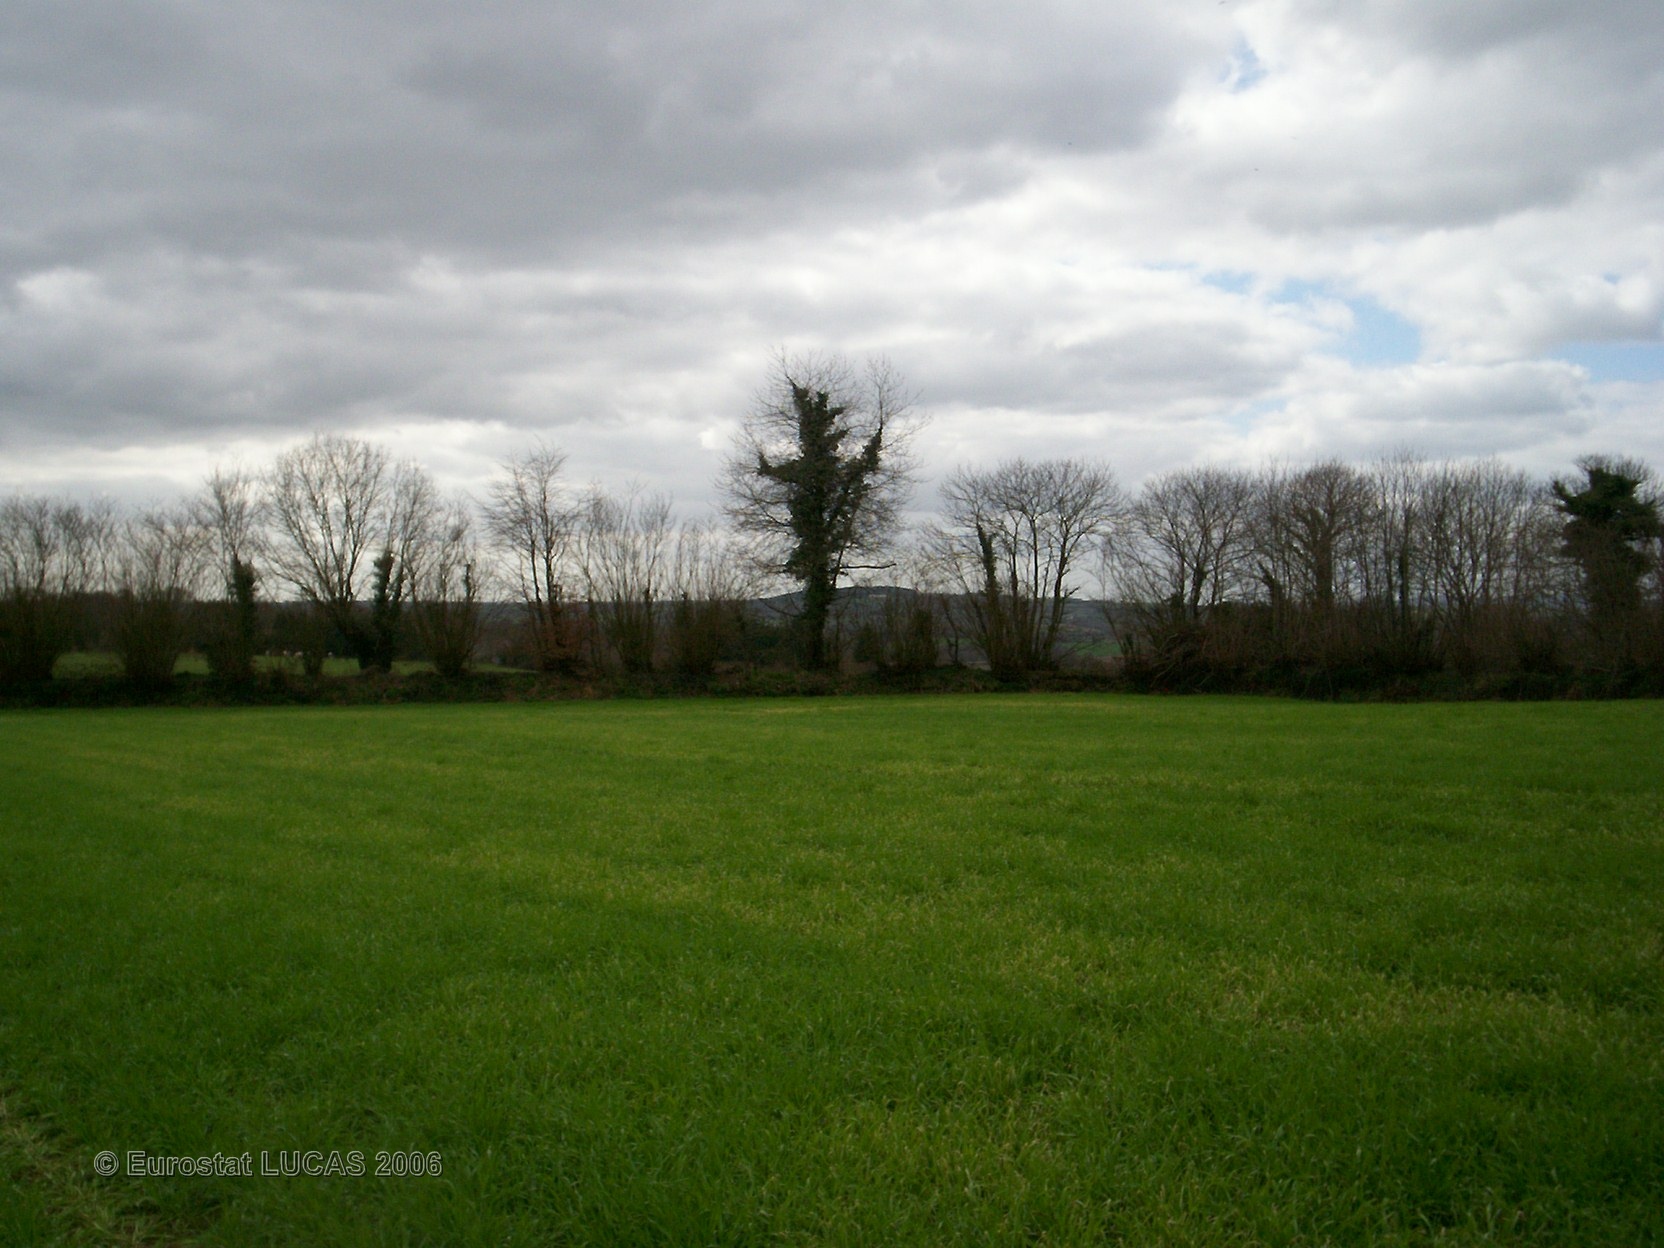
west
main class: Cropland
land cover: Barley
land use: Agriculture (excluding fallow land and kitchen gardens)
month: April
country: FR
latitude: 48.1053
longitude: -3.6030
